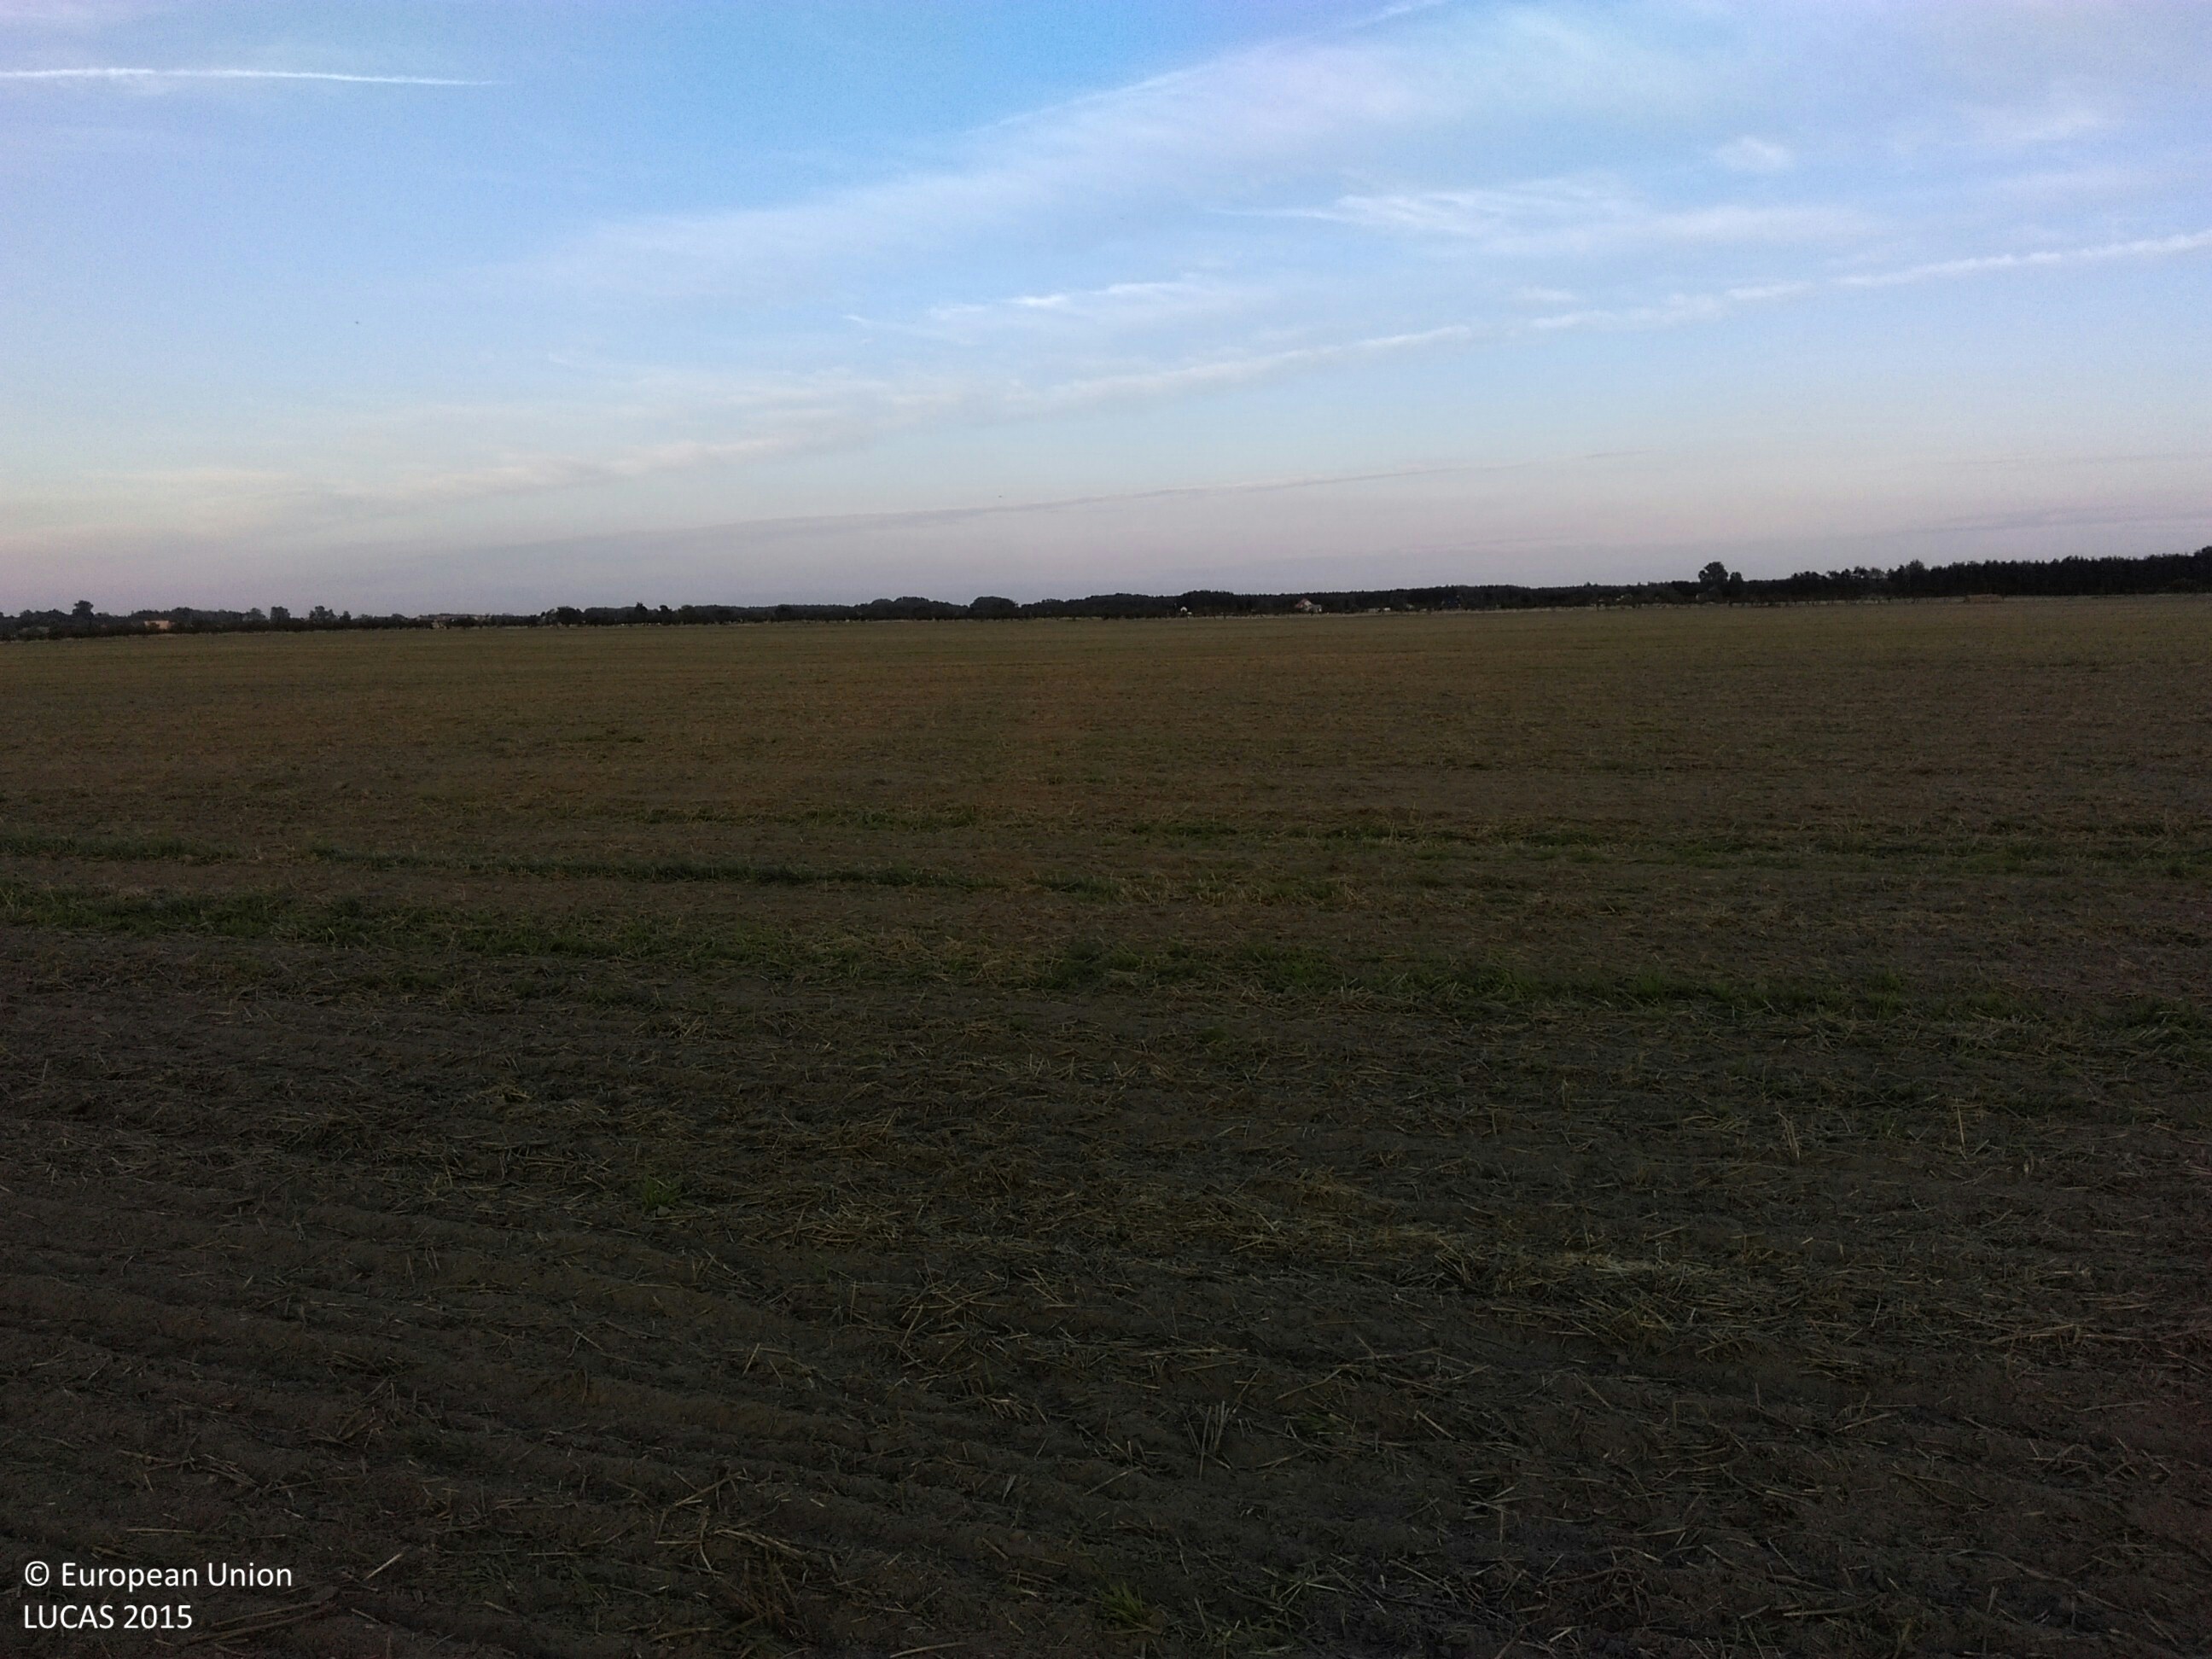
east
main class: Cropland
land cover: Rye
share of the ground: 10 - 25 %
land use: Agriculture (excluding fallow land and kitchen gardens)
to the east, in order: Rye
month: September
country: PL
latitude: 52.1261
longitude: 16.1851
